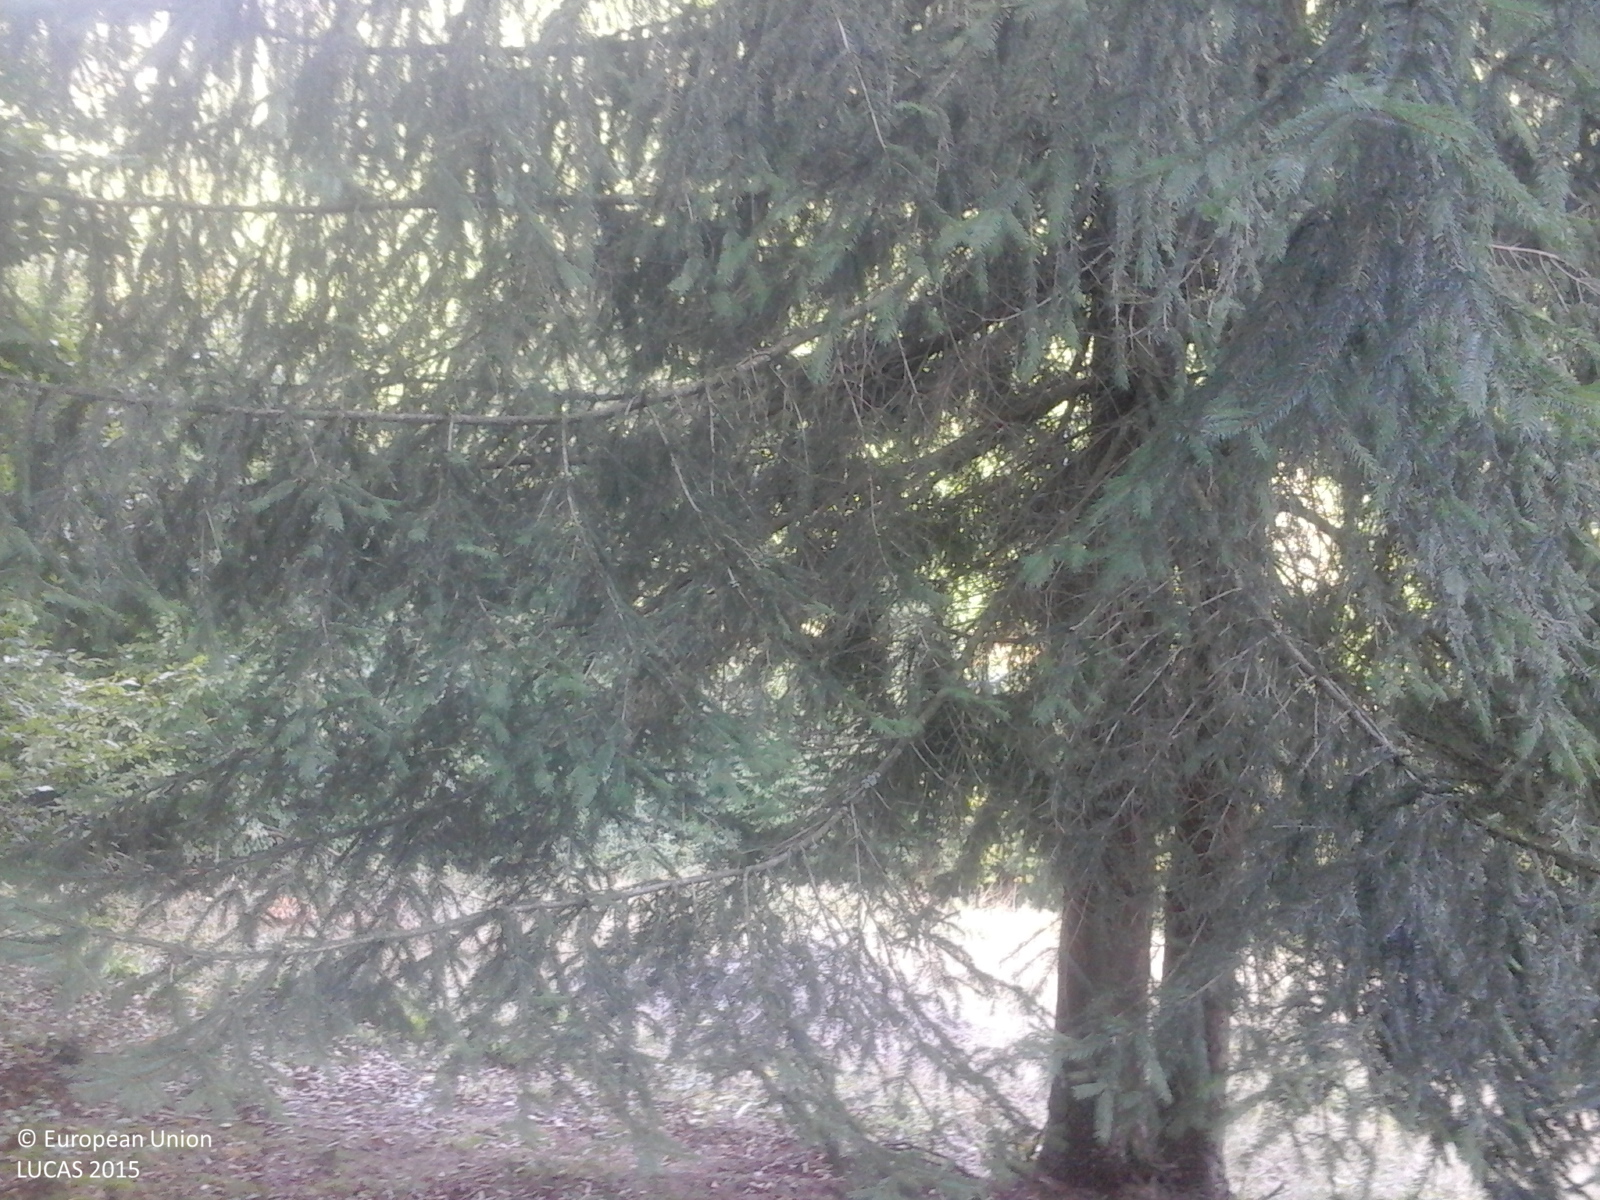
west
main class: Grassland
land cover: Grassland without tree/shrub cover
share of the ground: > 75 %
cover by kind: herbaceous plants 100 %
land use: Agriculture (excluding fallow land and kitchen gardens)
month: September
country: RO
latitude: 46.8203
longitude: 22.6251
